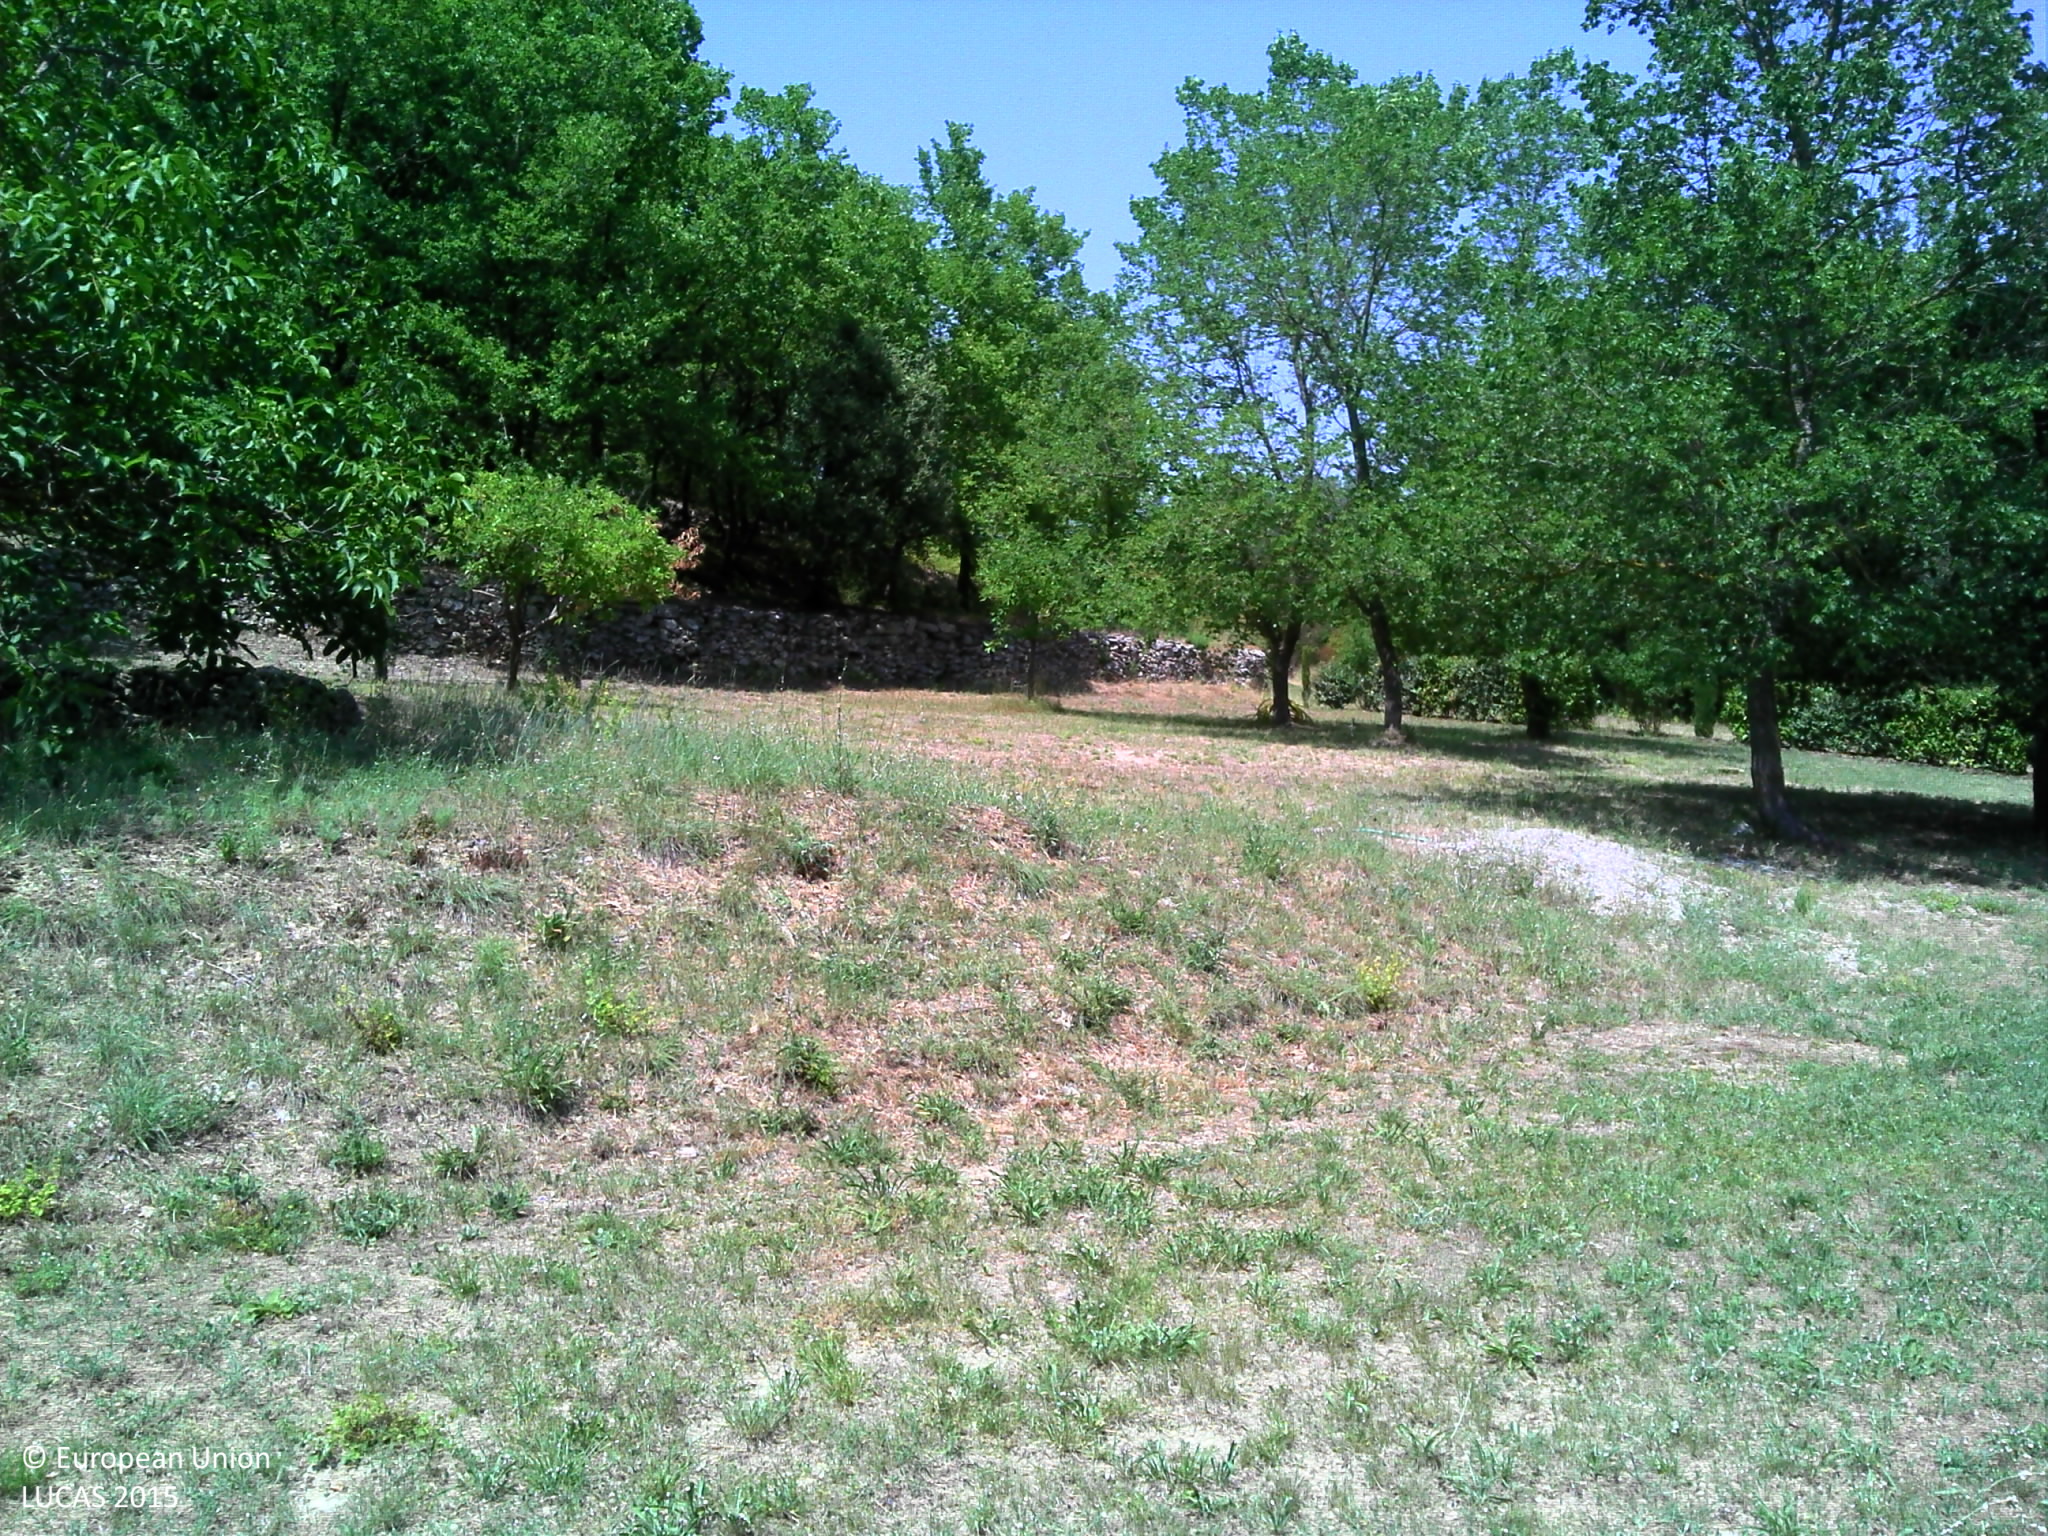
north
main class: Grassland
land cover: Grassland without tree/shrub cover
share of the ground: 50 - 75 %
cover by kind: herbaceous plants 85 %, consolidated bare surface 10 %, shrubs 5 %
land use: Residential
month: July
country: FR
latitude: 43.8595
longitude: 5.5919
